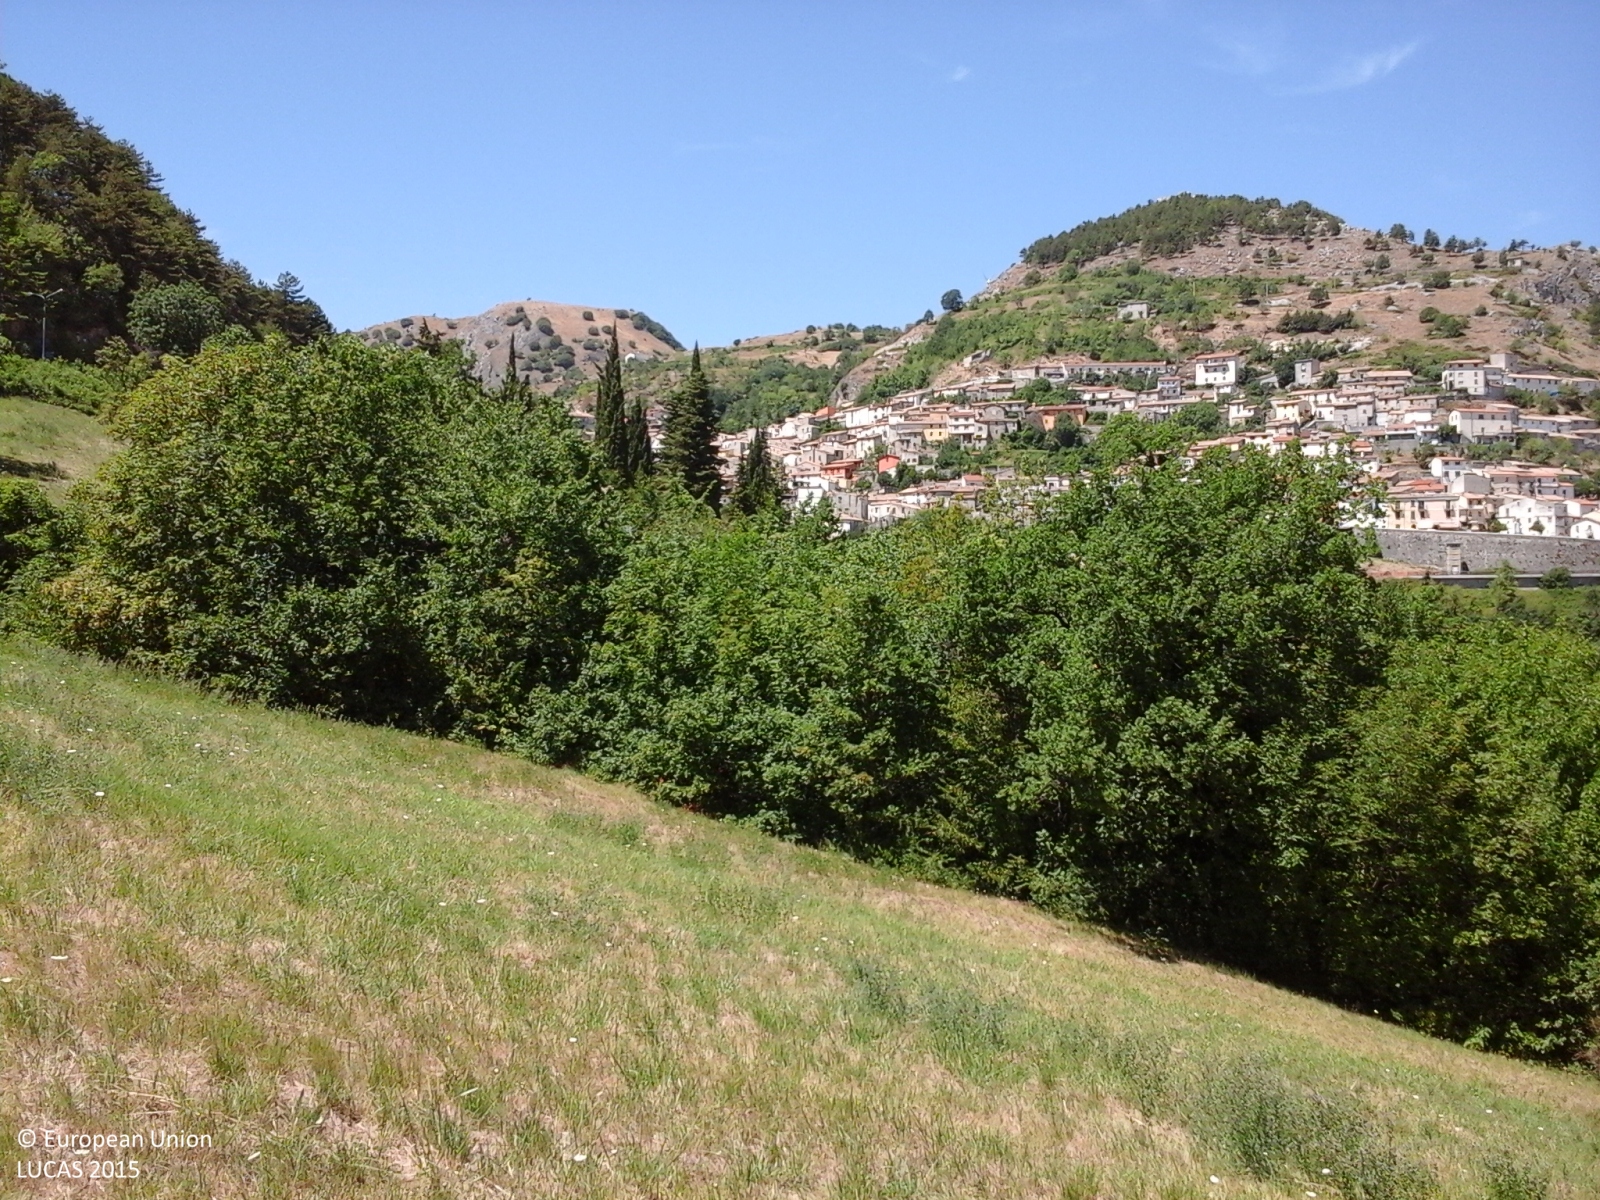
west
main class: Grassland
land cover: Grassland without tree/shrub cover
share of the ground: > 75 %
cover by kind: herbaceous plants 100 %
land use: Agriculture (excluding fallow land and kitchen gardens)
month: July
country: IT
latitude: 41.4928
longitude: 14.3562
